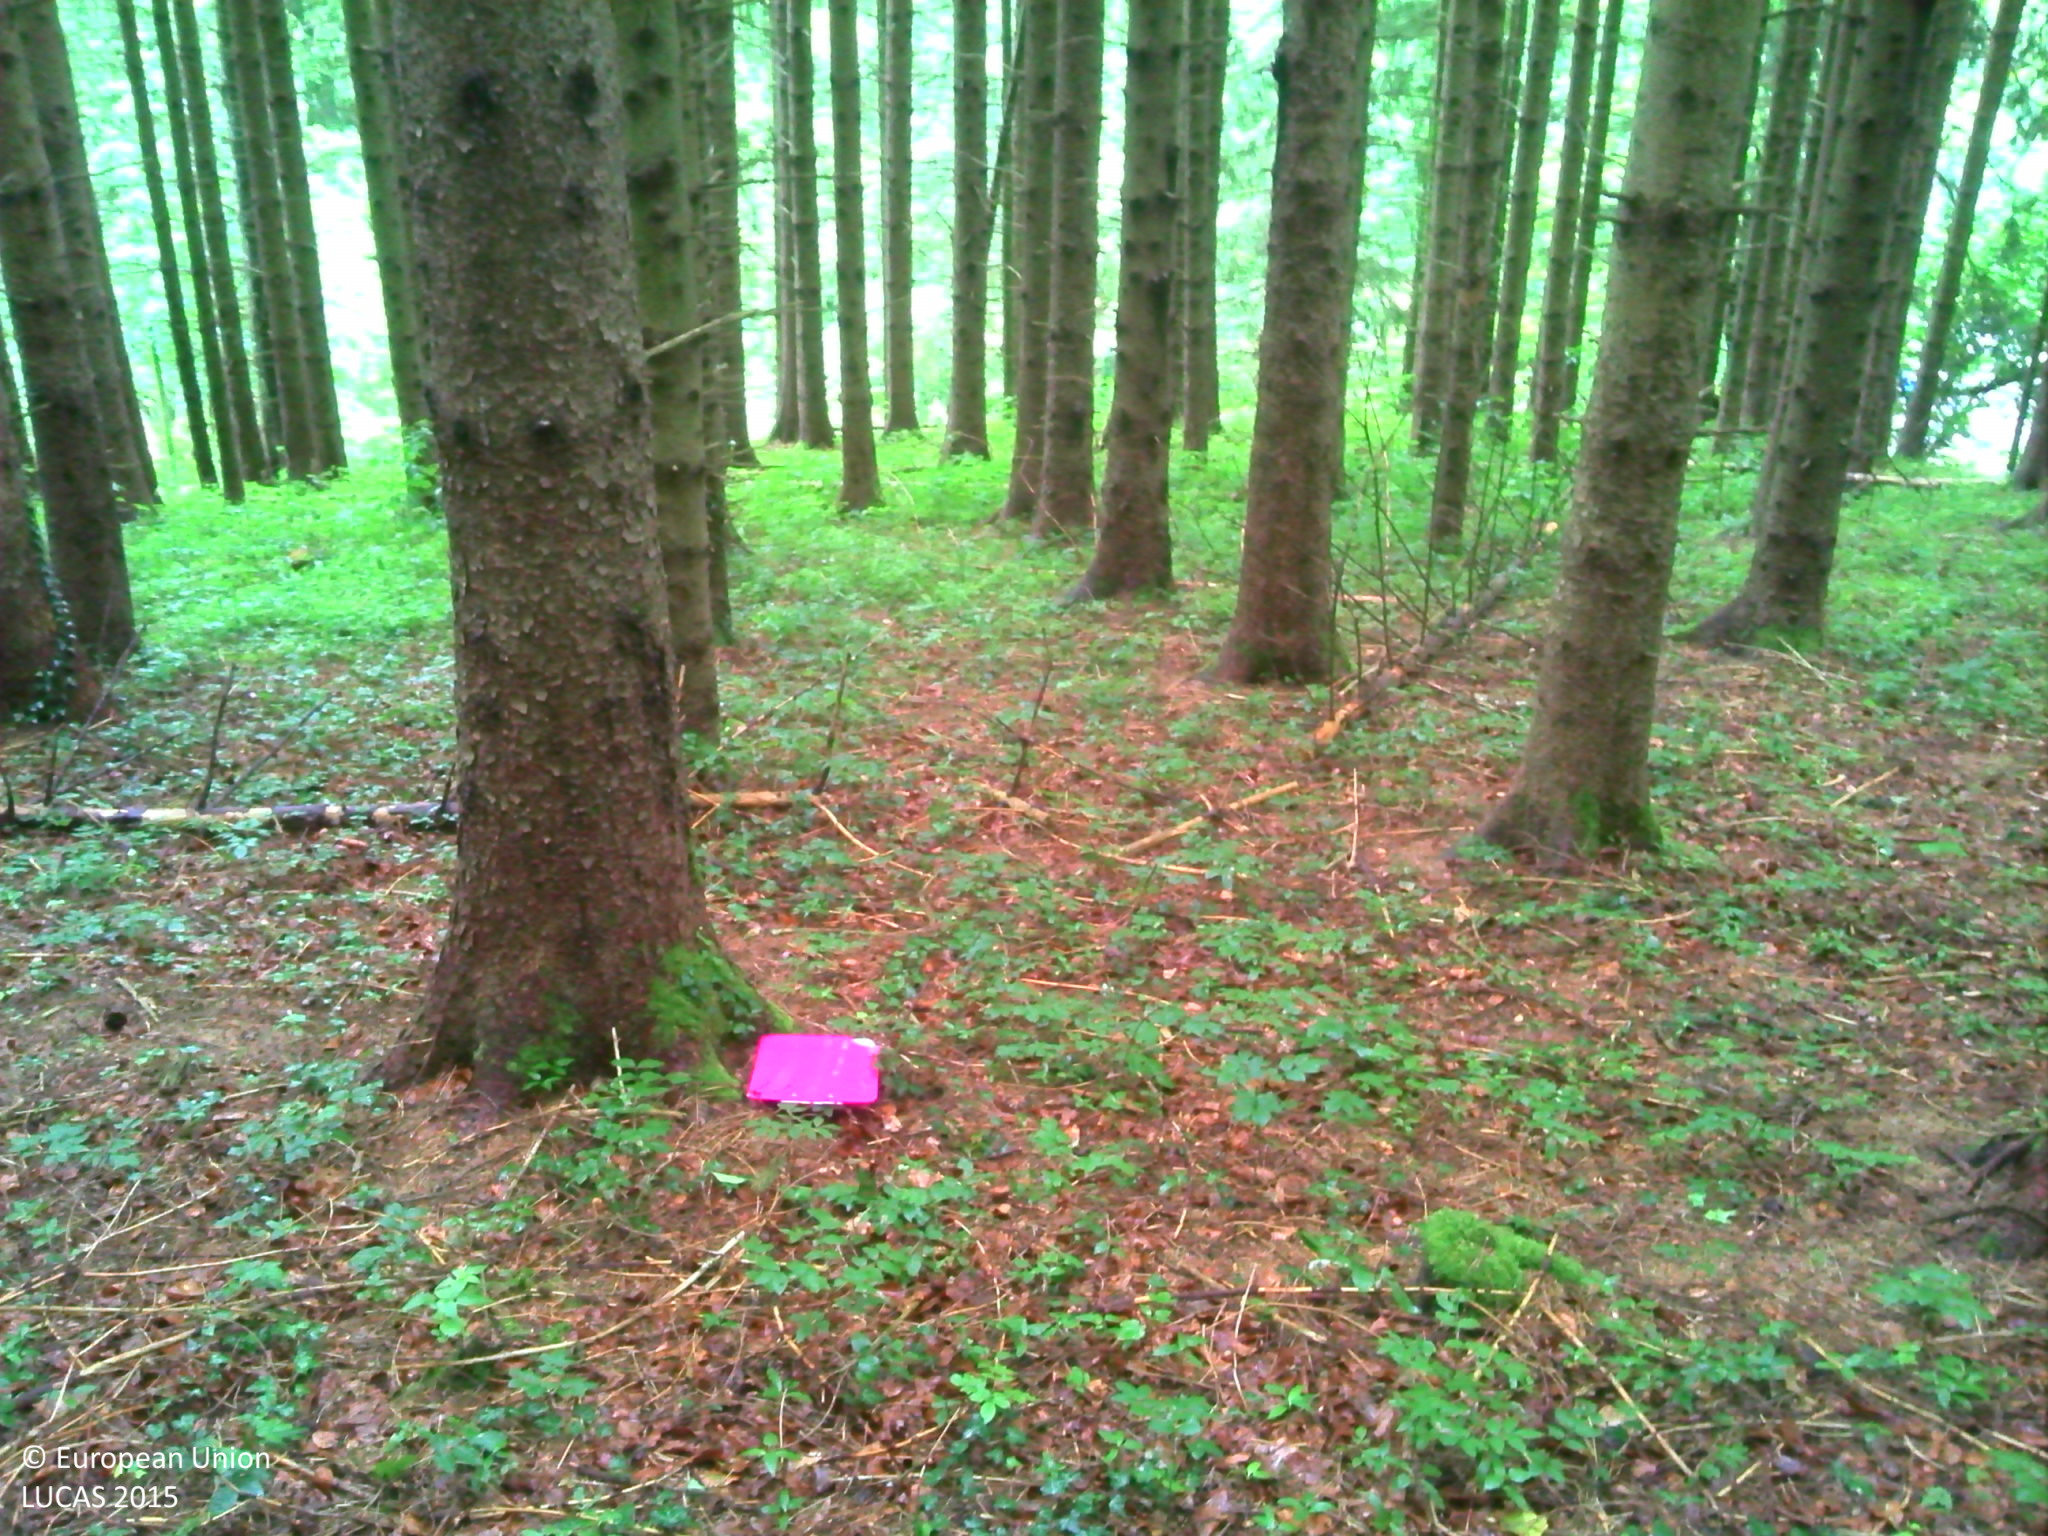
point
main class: Woodland
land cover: Spruce dominated coniferous woodland
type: alpine coniferous forest
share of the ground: > 75 %
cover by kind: coniferous forest trees 70 %, broadleaved forest trees 15 %, herbaceous plants 10 %, lichens and mosses 5 %
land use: Forestry
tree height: > 5 m
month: July
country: FR
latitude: 45.9798
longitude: 6.2735
